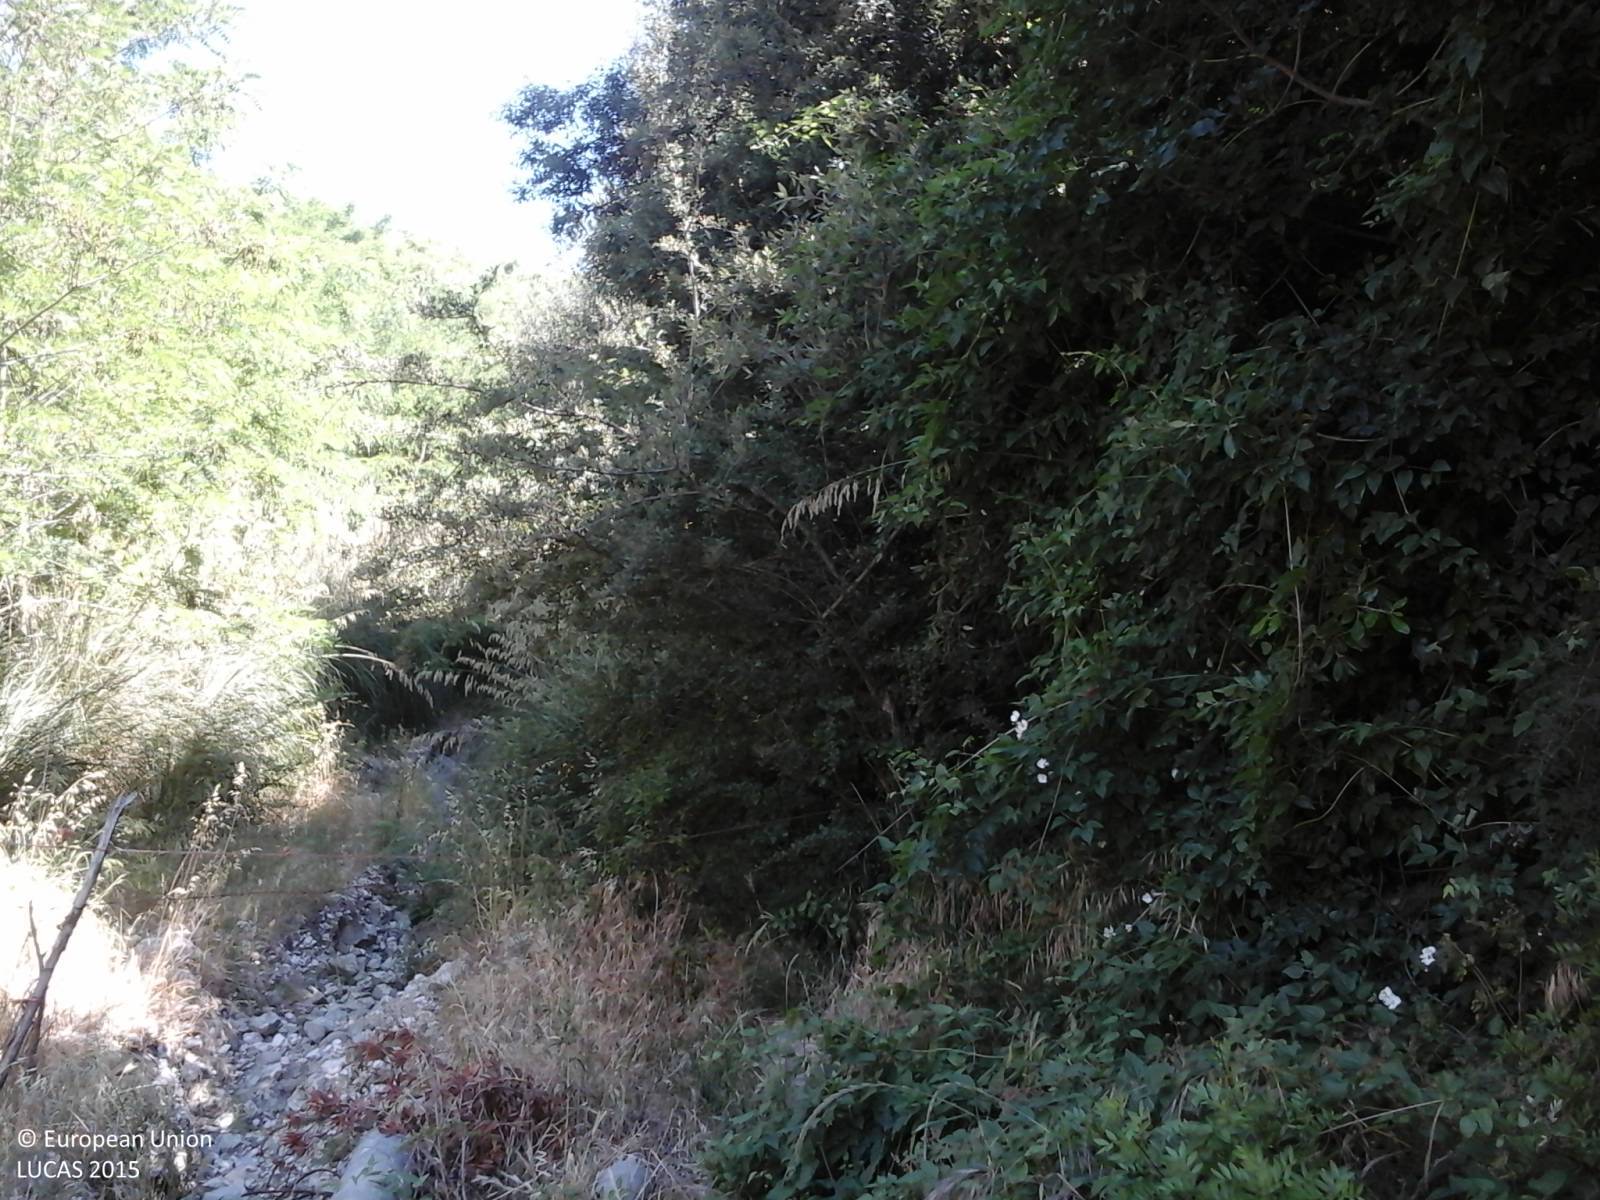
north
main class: Woodland
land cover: Broadleaved woodland
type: thermophilous deciduous forest
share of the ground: > 75 %
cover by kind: broadleaved forest trees 100 %
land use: Forestry
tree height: < 5 m
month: June
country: IT
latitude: 41.3375
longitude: 14.1784
